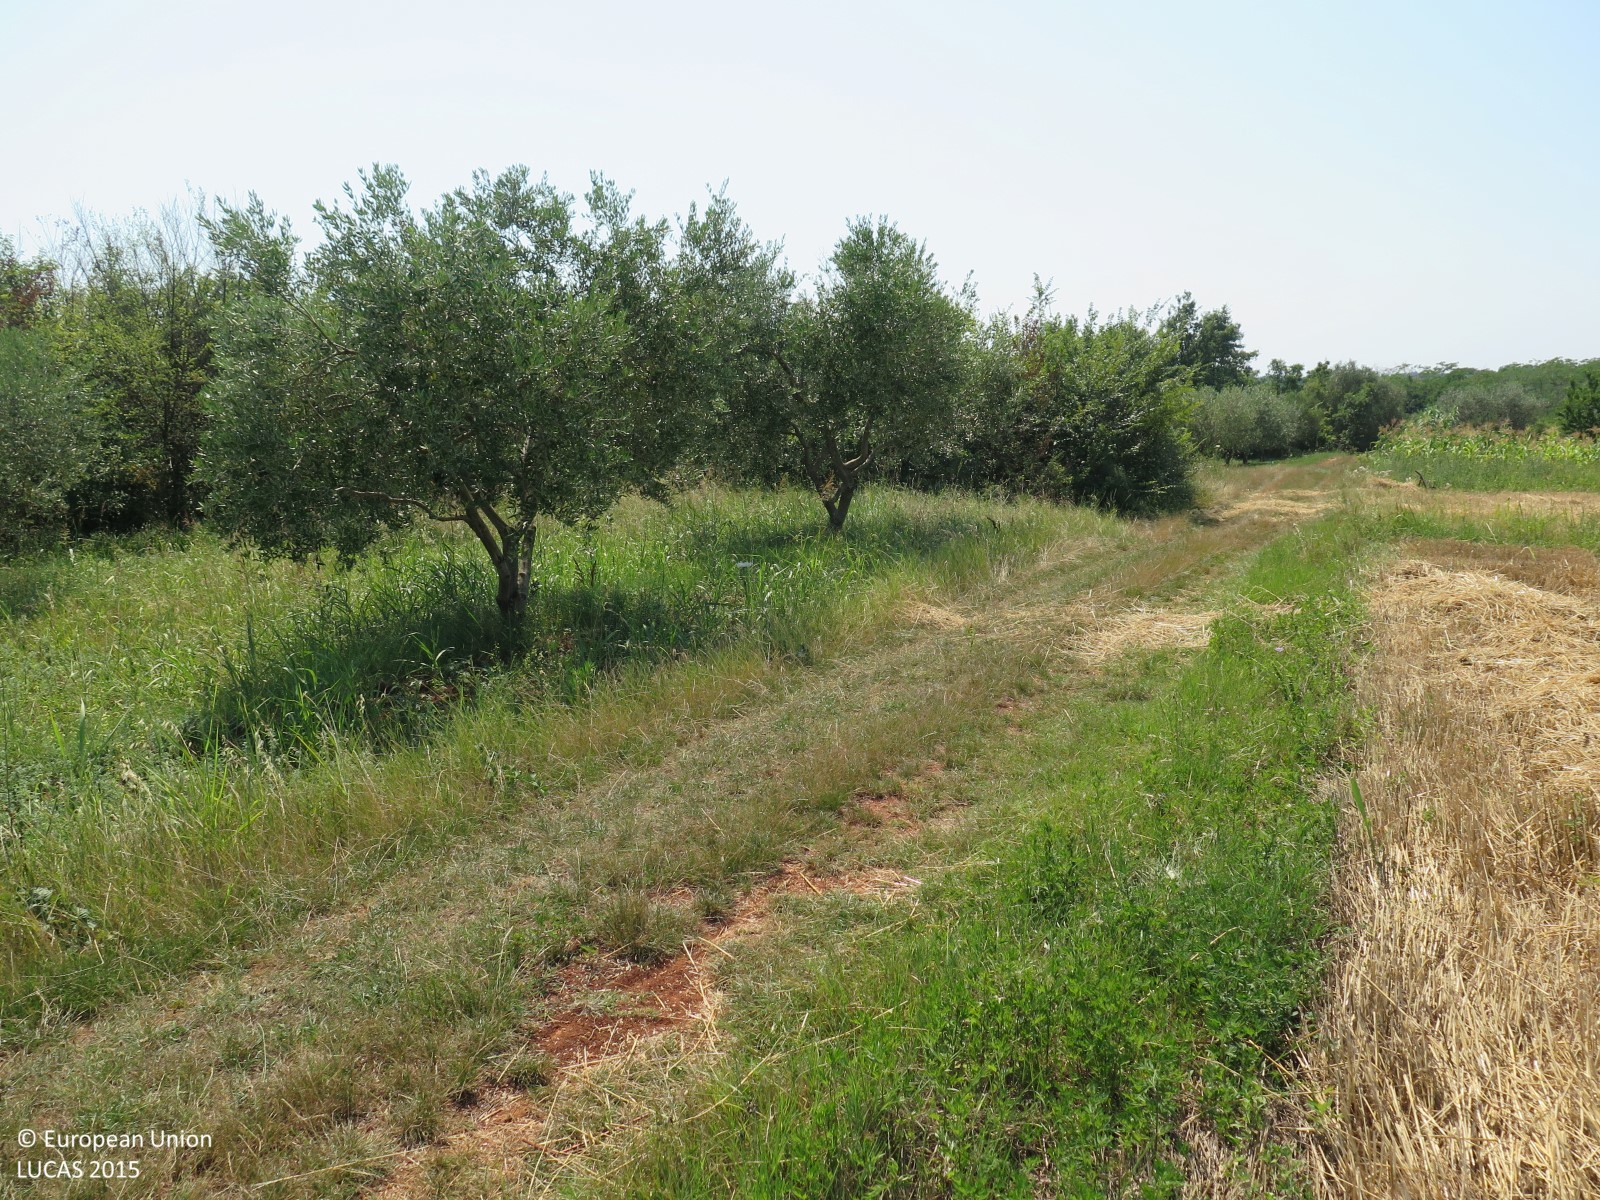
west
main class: Cropland
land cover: Oats
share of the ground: > 75 %
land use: Agriculture (excluding fallow land and kitchen gardens)
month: July
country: HR
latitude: 45.4623
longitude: 13.5635
